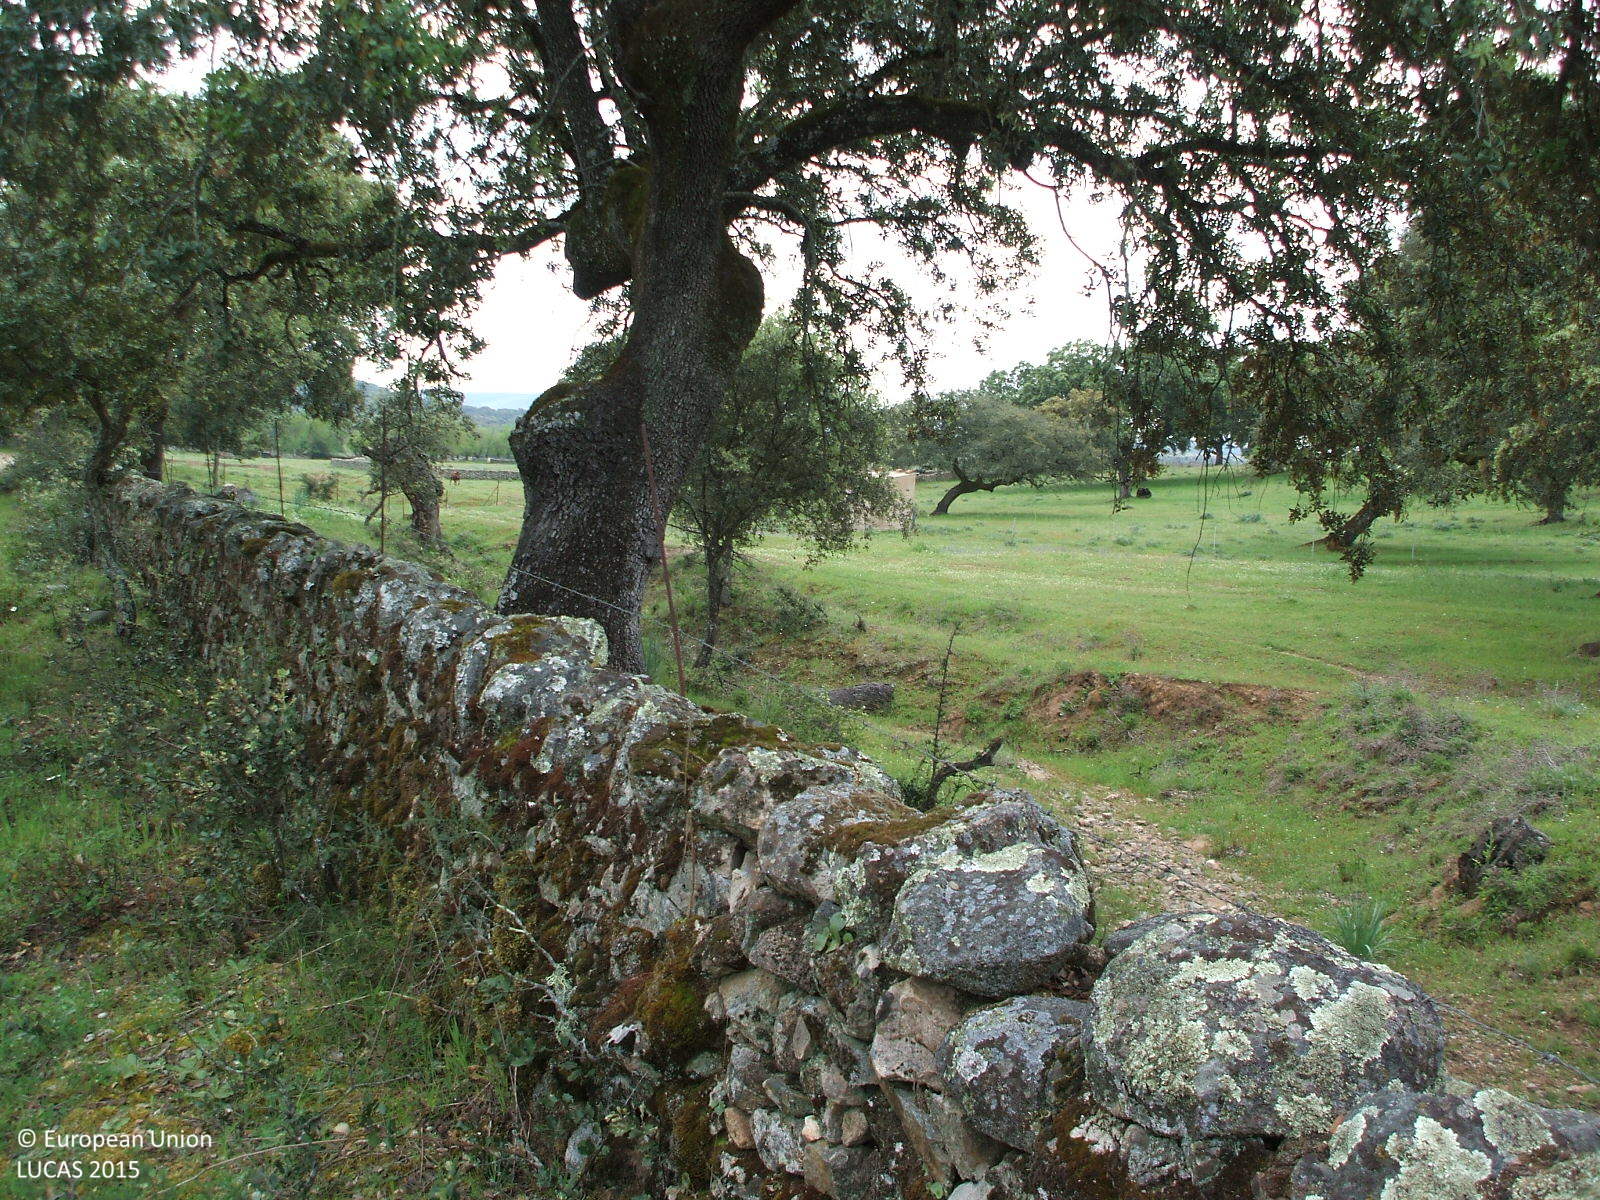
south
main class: Woodland
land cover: Broadleaved woodland
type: broadleaved evergreen forest
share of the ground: 25 - 50 %
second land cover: Grassland without tree/shrub cover
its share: > 75 %
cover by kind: herbaceous plants 70 %, broadleaved forest trees 30 %
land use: Forestry
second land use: Agriculture (excluding fallow land and kitchen gardens)
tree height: > 5 m
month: April
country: ES
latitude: 37.9513
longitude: -6.2095
